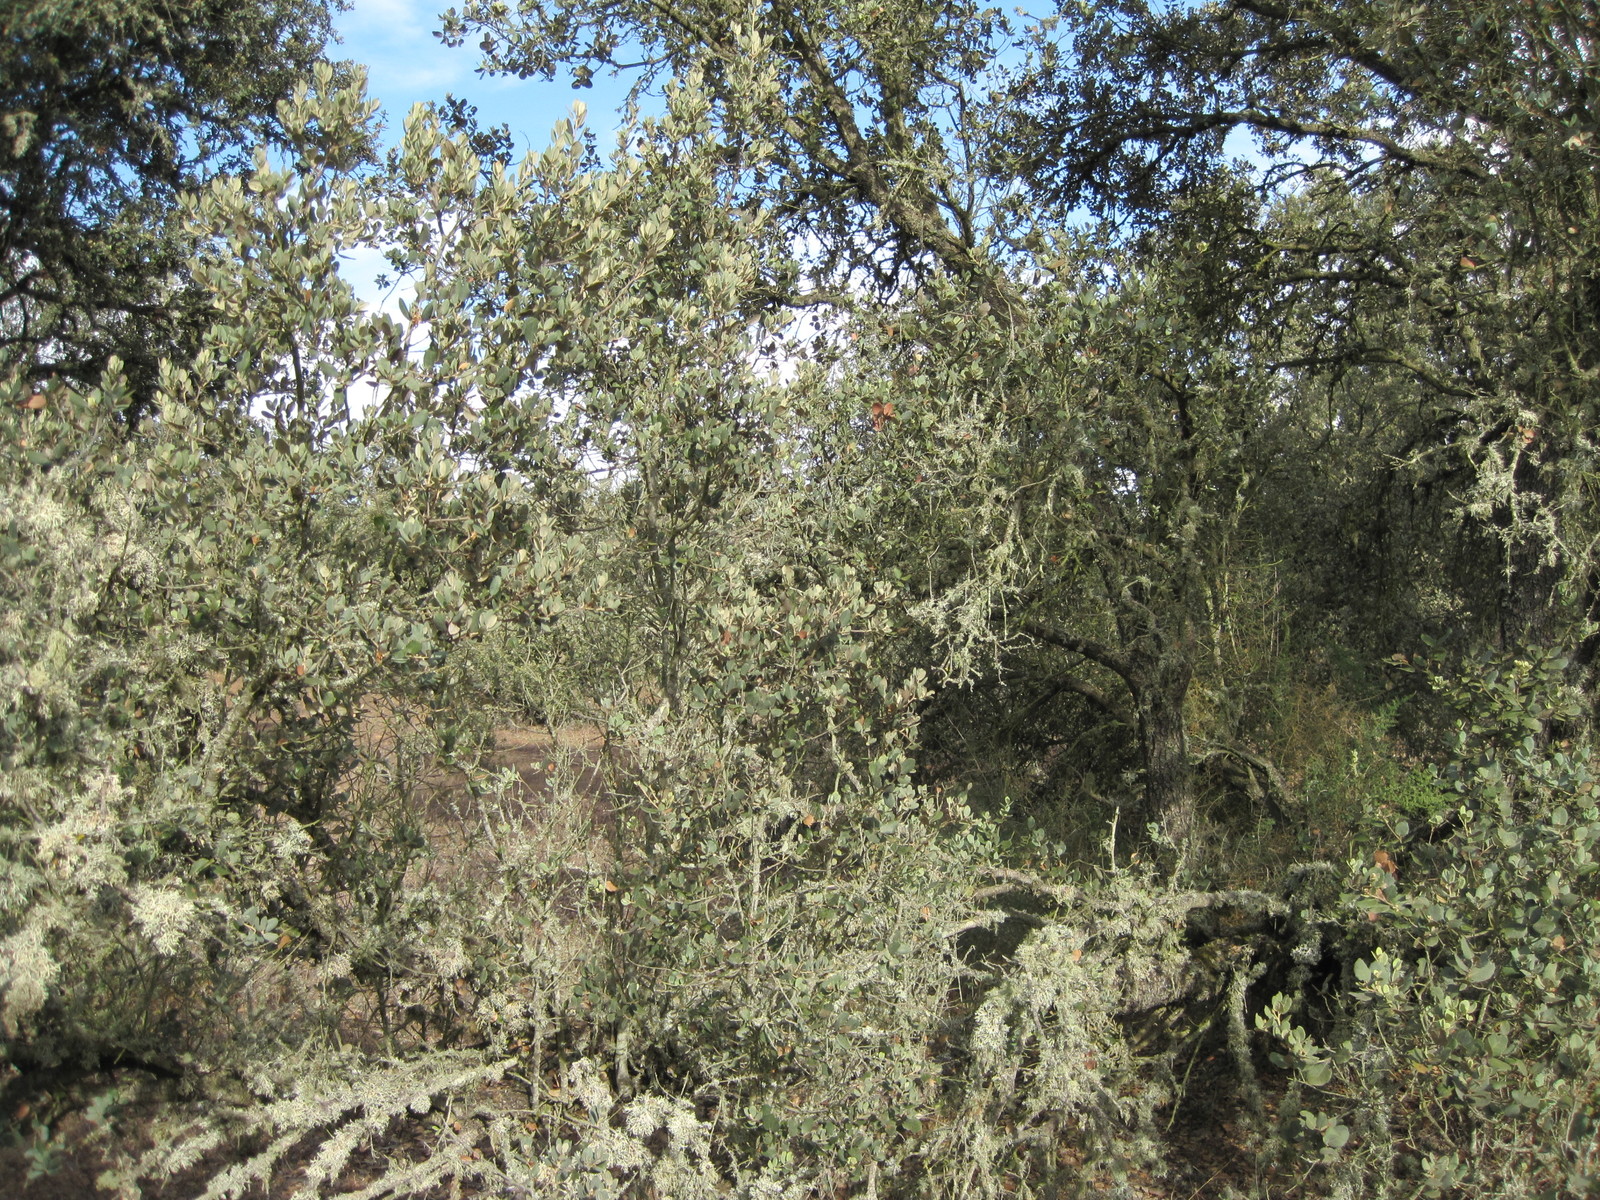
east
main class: Woodland
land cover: Broadleaved woodland
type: broadleaved evergreen forest
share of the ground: 50 - 75 %
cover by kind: broadleaved forest trees 70 %, herbaceous plants 30 %
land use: Forestry
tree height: > 5 m
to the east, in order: Broadleaved woodland
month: July
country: ES
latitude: 41.9270
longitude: -5.6340
